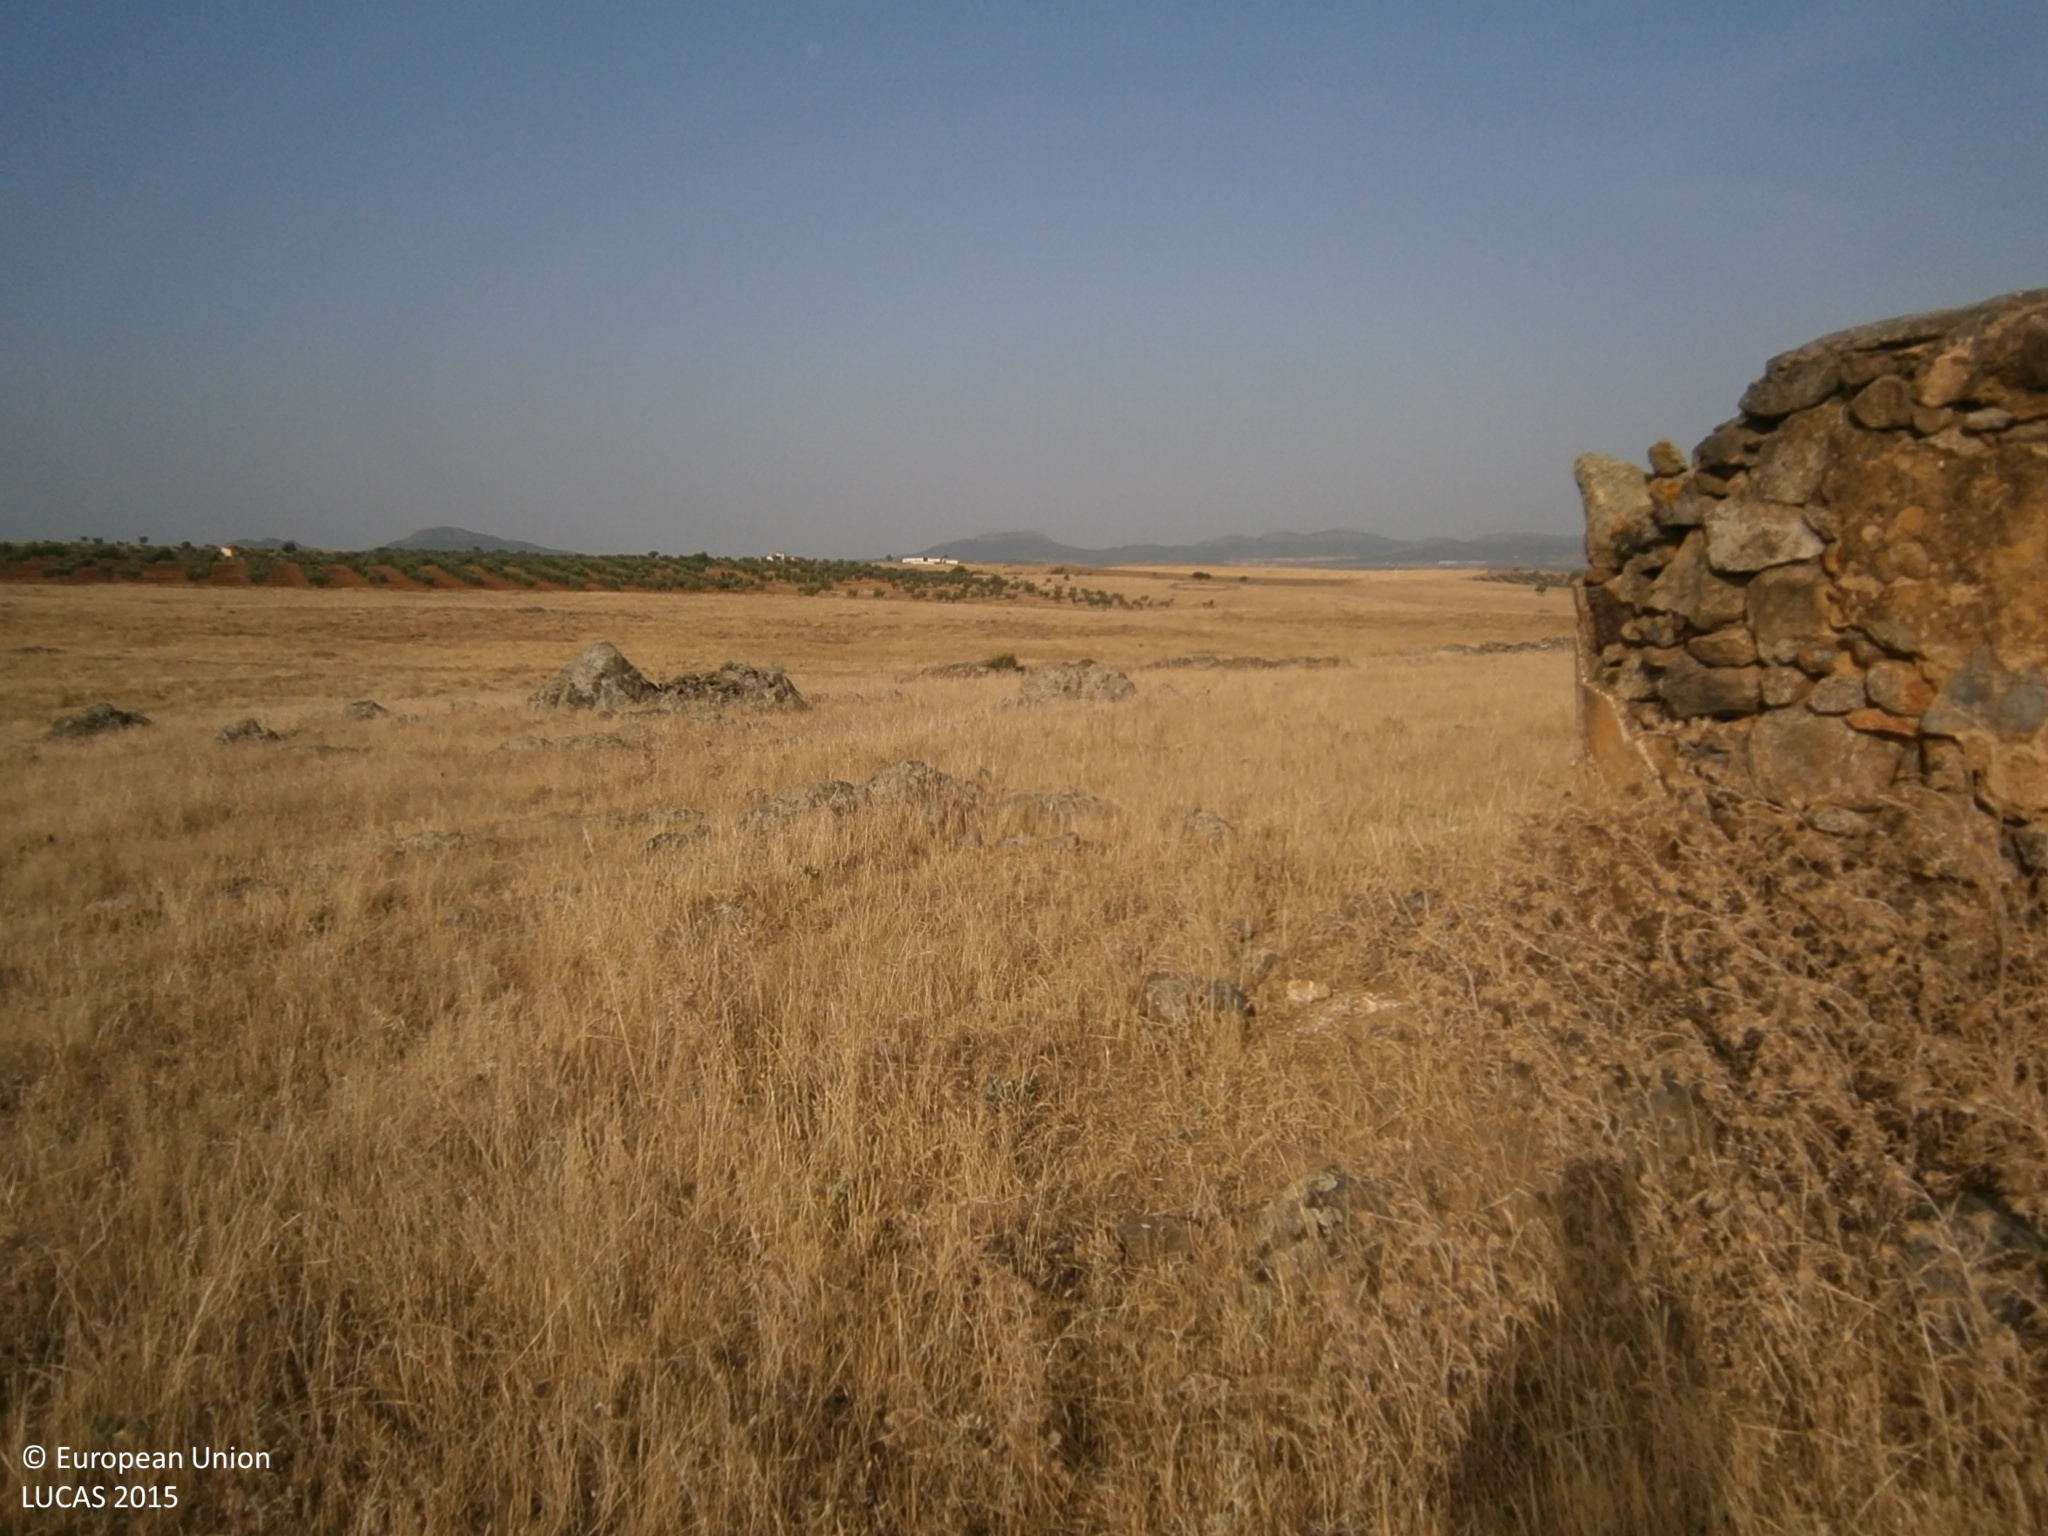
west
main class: Grassland
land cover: Grassland without tree/shrub cover
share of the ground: > 75 %
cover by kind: herbaceous plants 90 %
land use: Agriculture (excluding fallow land and kitchen gardens)
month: June
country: ES
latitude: 38.8798
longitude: -6.2745
